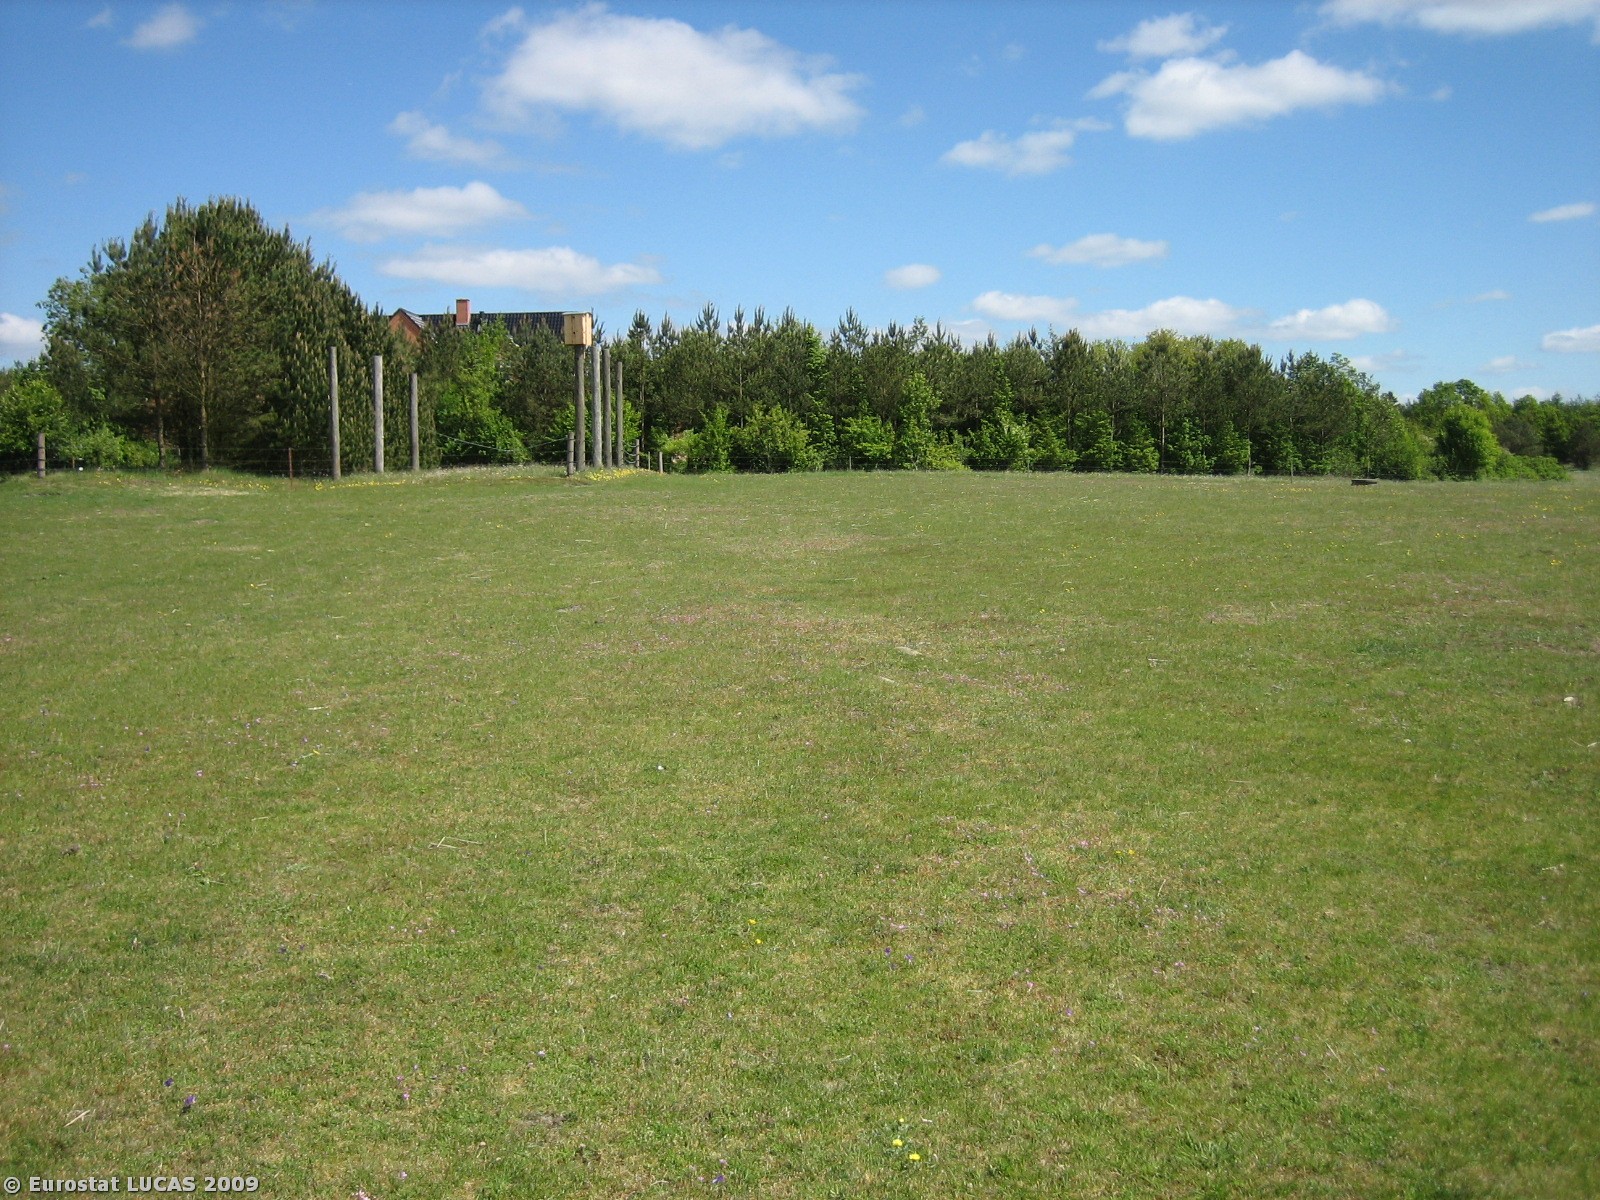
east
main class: Grassland
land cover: Grassland without tree/shrub cover
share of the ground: > 75 %
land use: Residential
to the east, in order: Grassland without tree/shrub cover; Fences; Mixed woodland; Artificial constructions in urban areas; Mixed woodland; Tracks; Grass margins; Managed hedges; Grassland without tree/shrub cover; Broadleaved woodland; Grassland without tree/shrub cover; Coniferous woodland
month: May
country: DK
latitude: 56.0399
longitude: 8.9899
